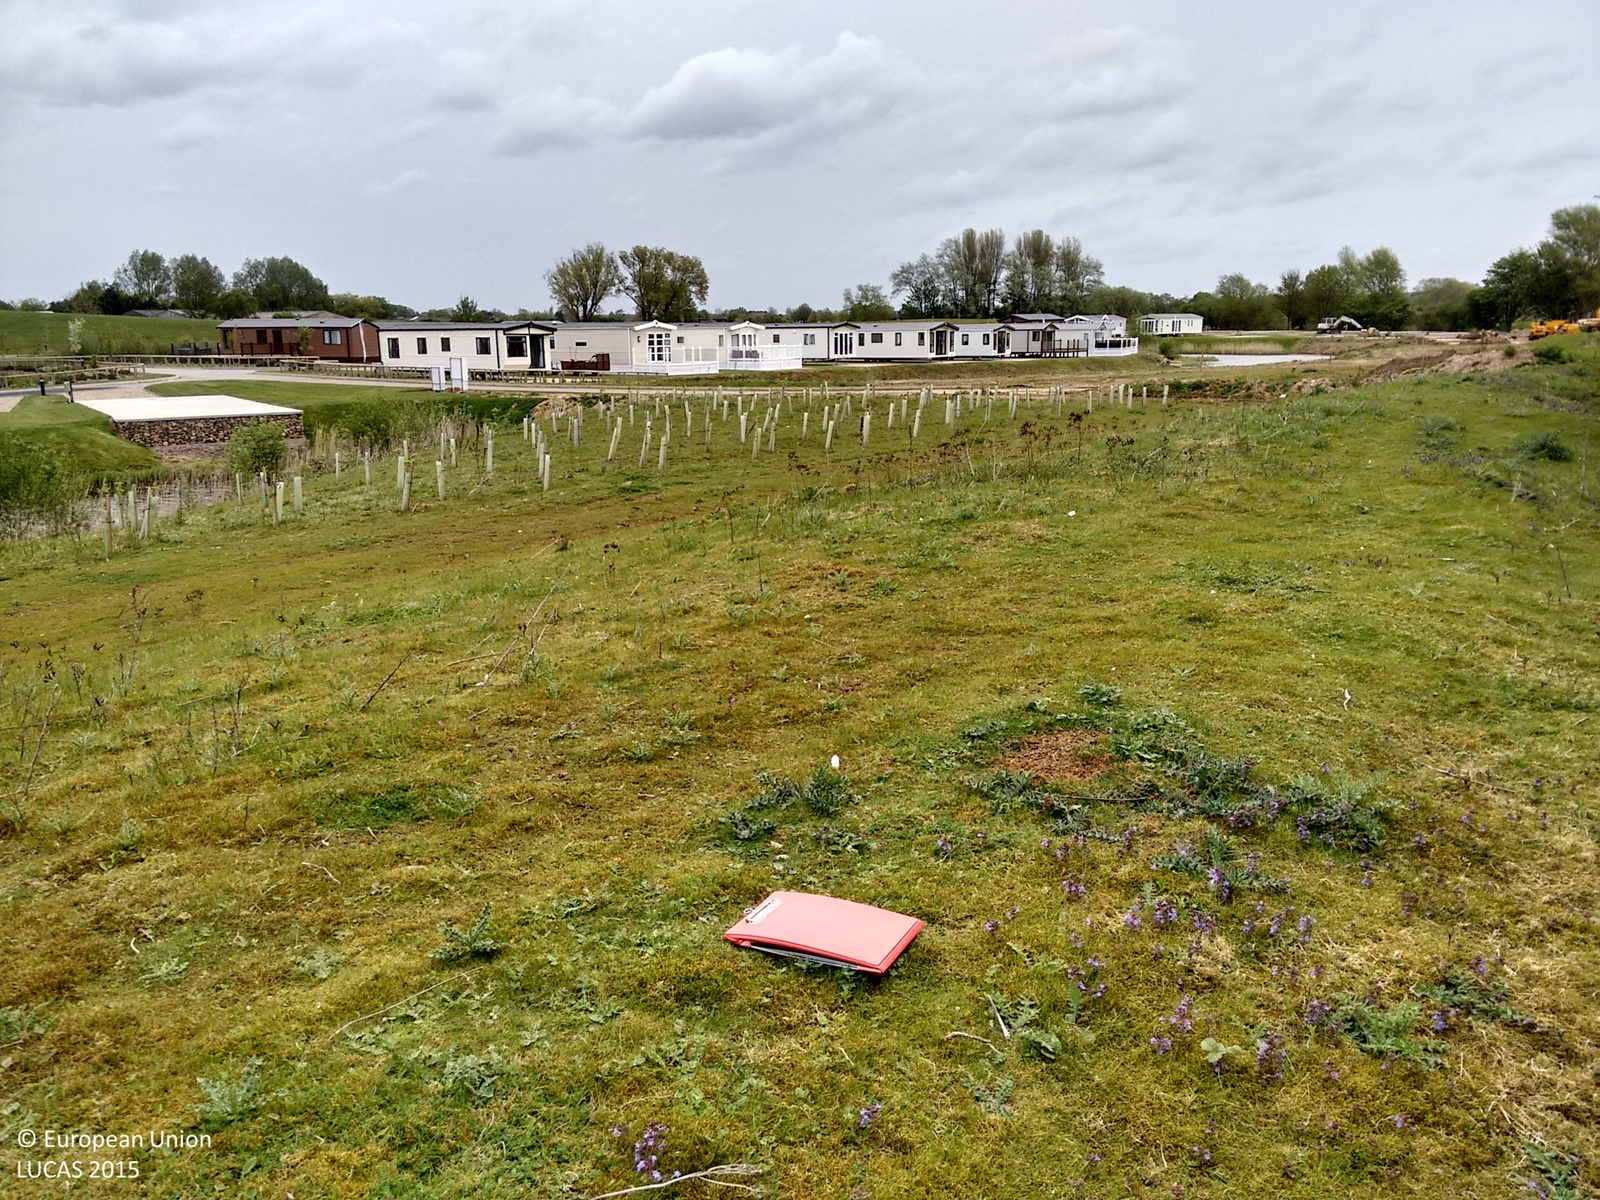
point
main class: Grassland
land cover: Grassland without tree/shrub cover
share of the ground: > 75 %
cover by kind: herbaceous plants 100 %
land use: Amenities, museums, leisure
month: May
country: GB
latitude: 53.9036
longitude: -0.3083
